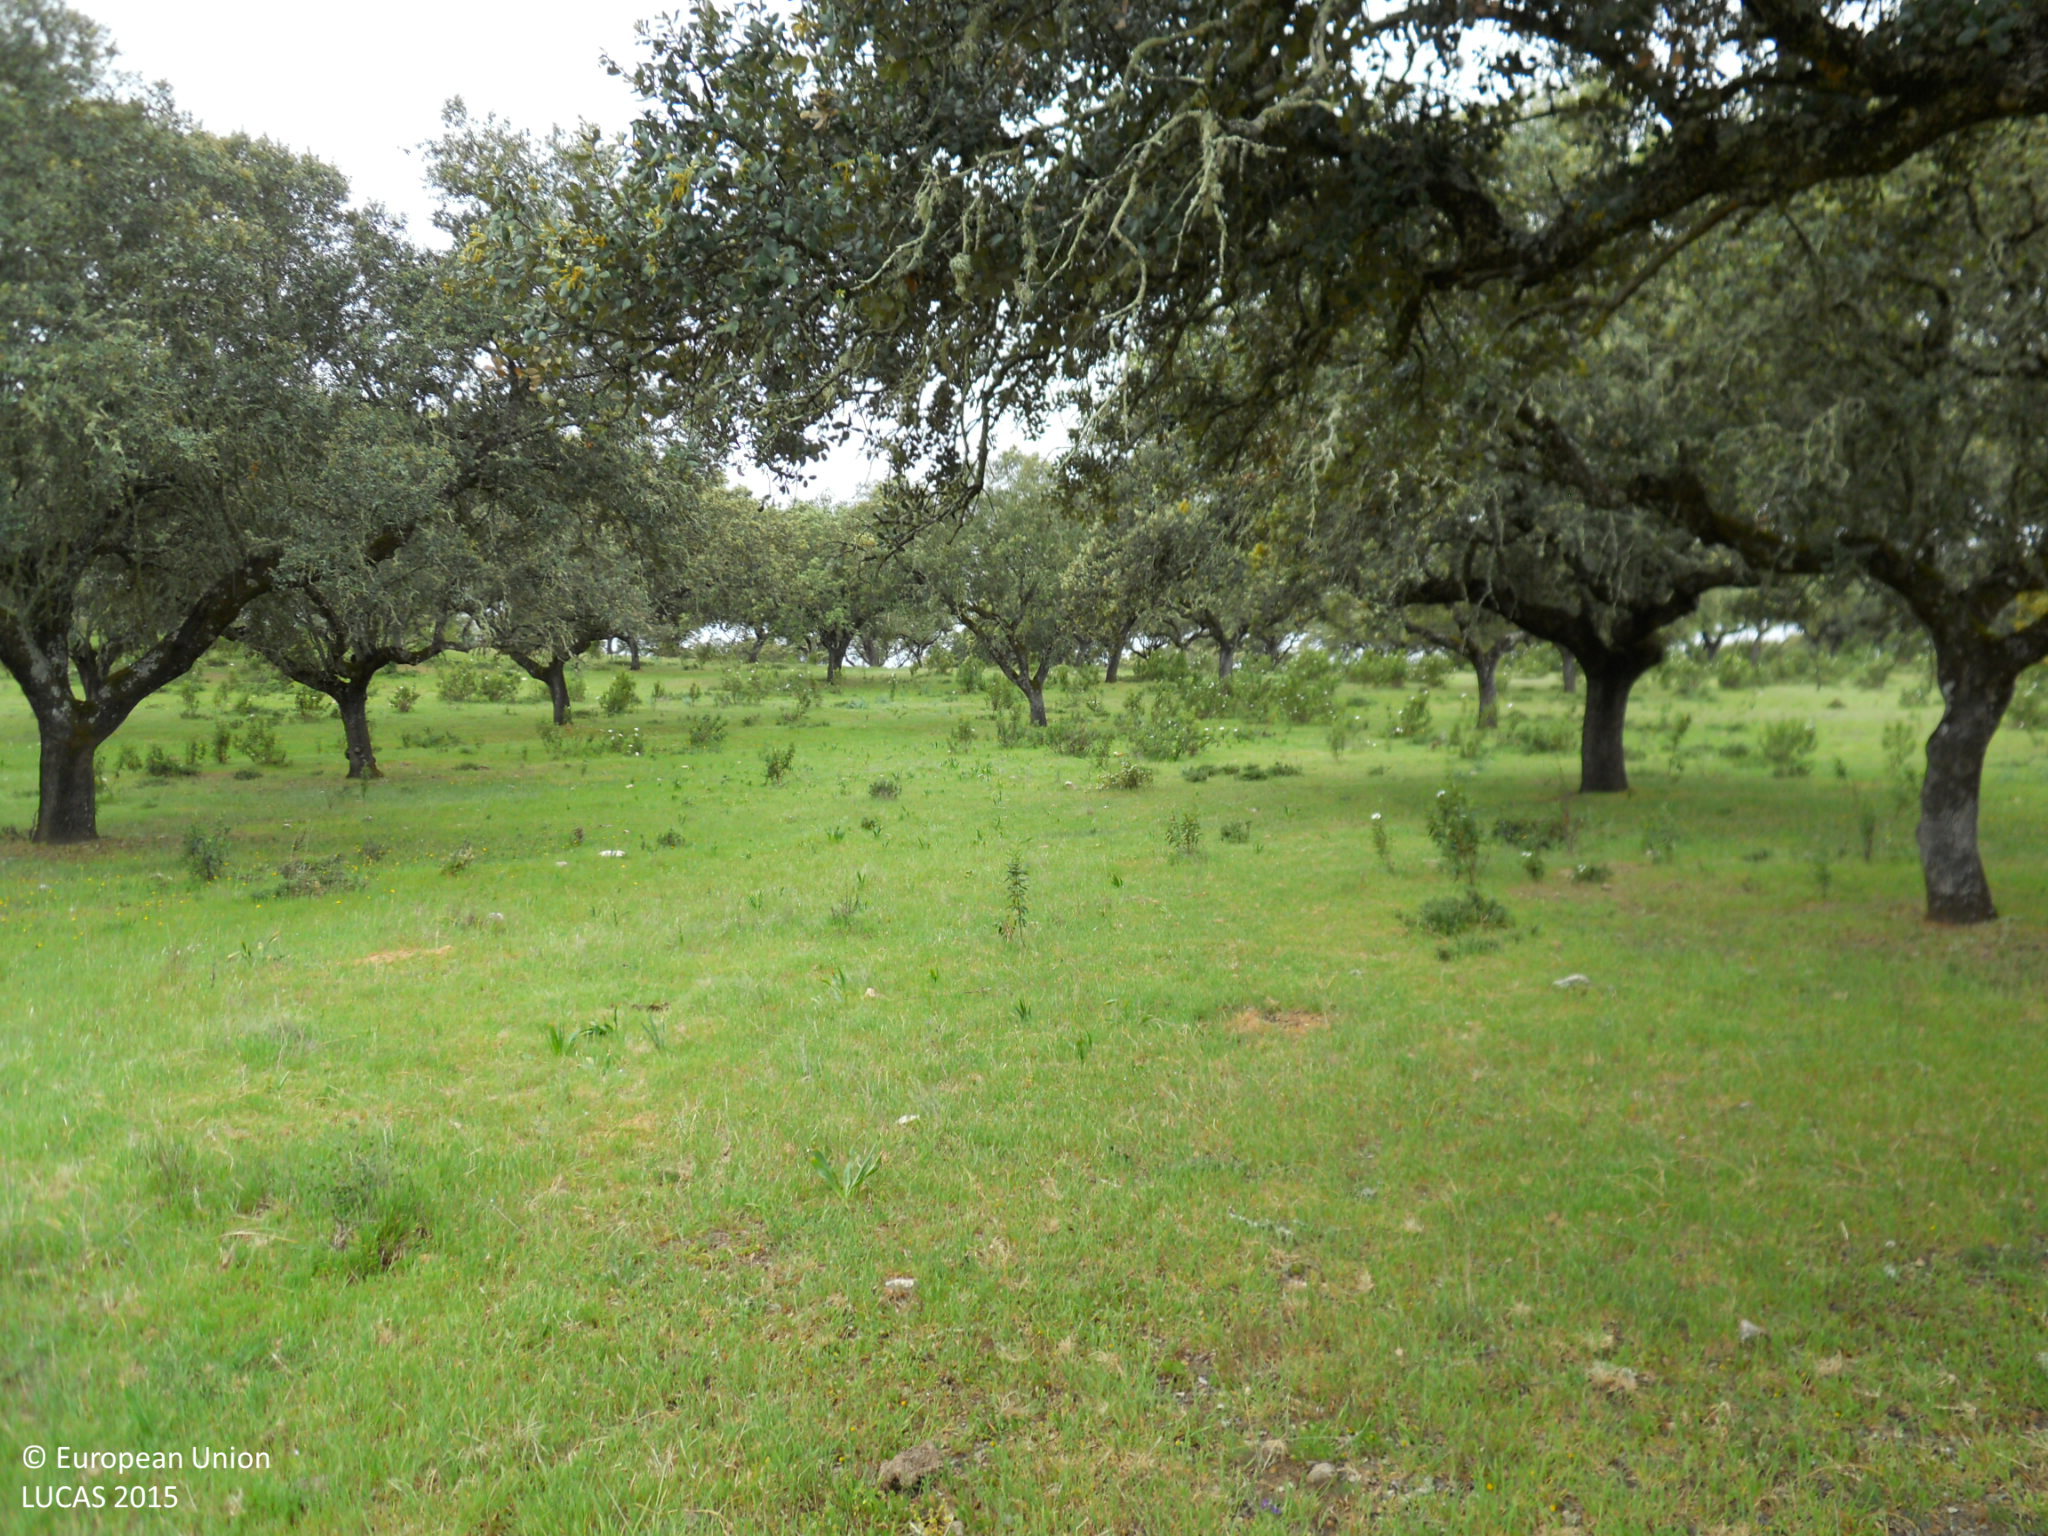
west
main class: Woodland
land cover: Broadleaved woodland
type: broadleaved evergreen forest
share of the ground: > 75 %
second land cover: Grassland without tree/shrub cover
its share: > 75 %
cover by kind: broadleaved forest trees 50 %, herbaceous plants 50 %
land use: Forestry
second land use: Agriculture (excluding fallow land and kitchen gardens)
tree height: > 5 m
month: April
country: ES
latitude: 39.1371
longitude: -6.5989
